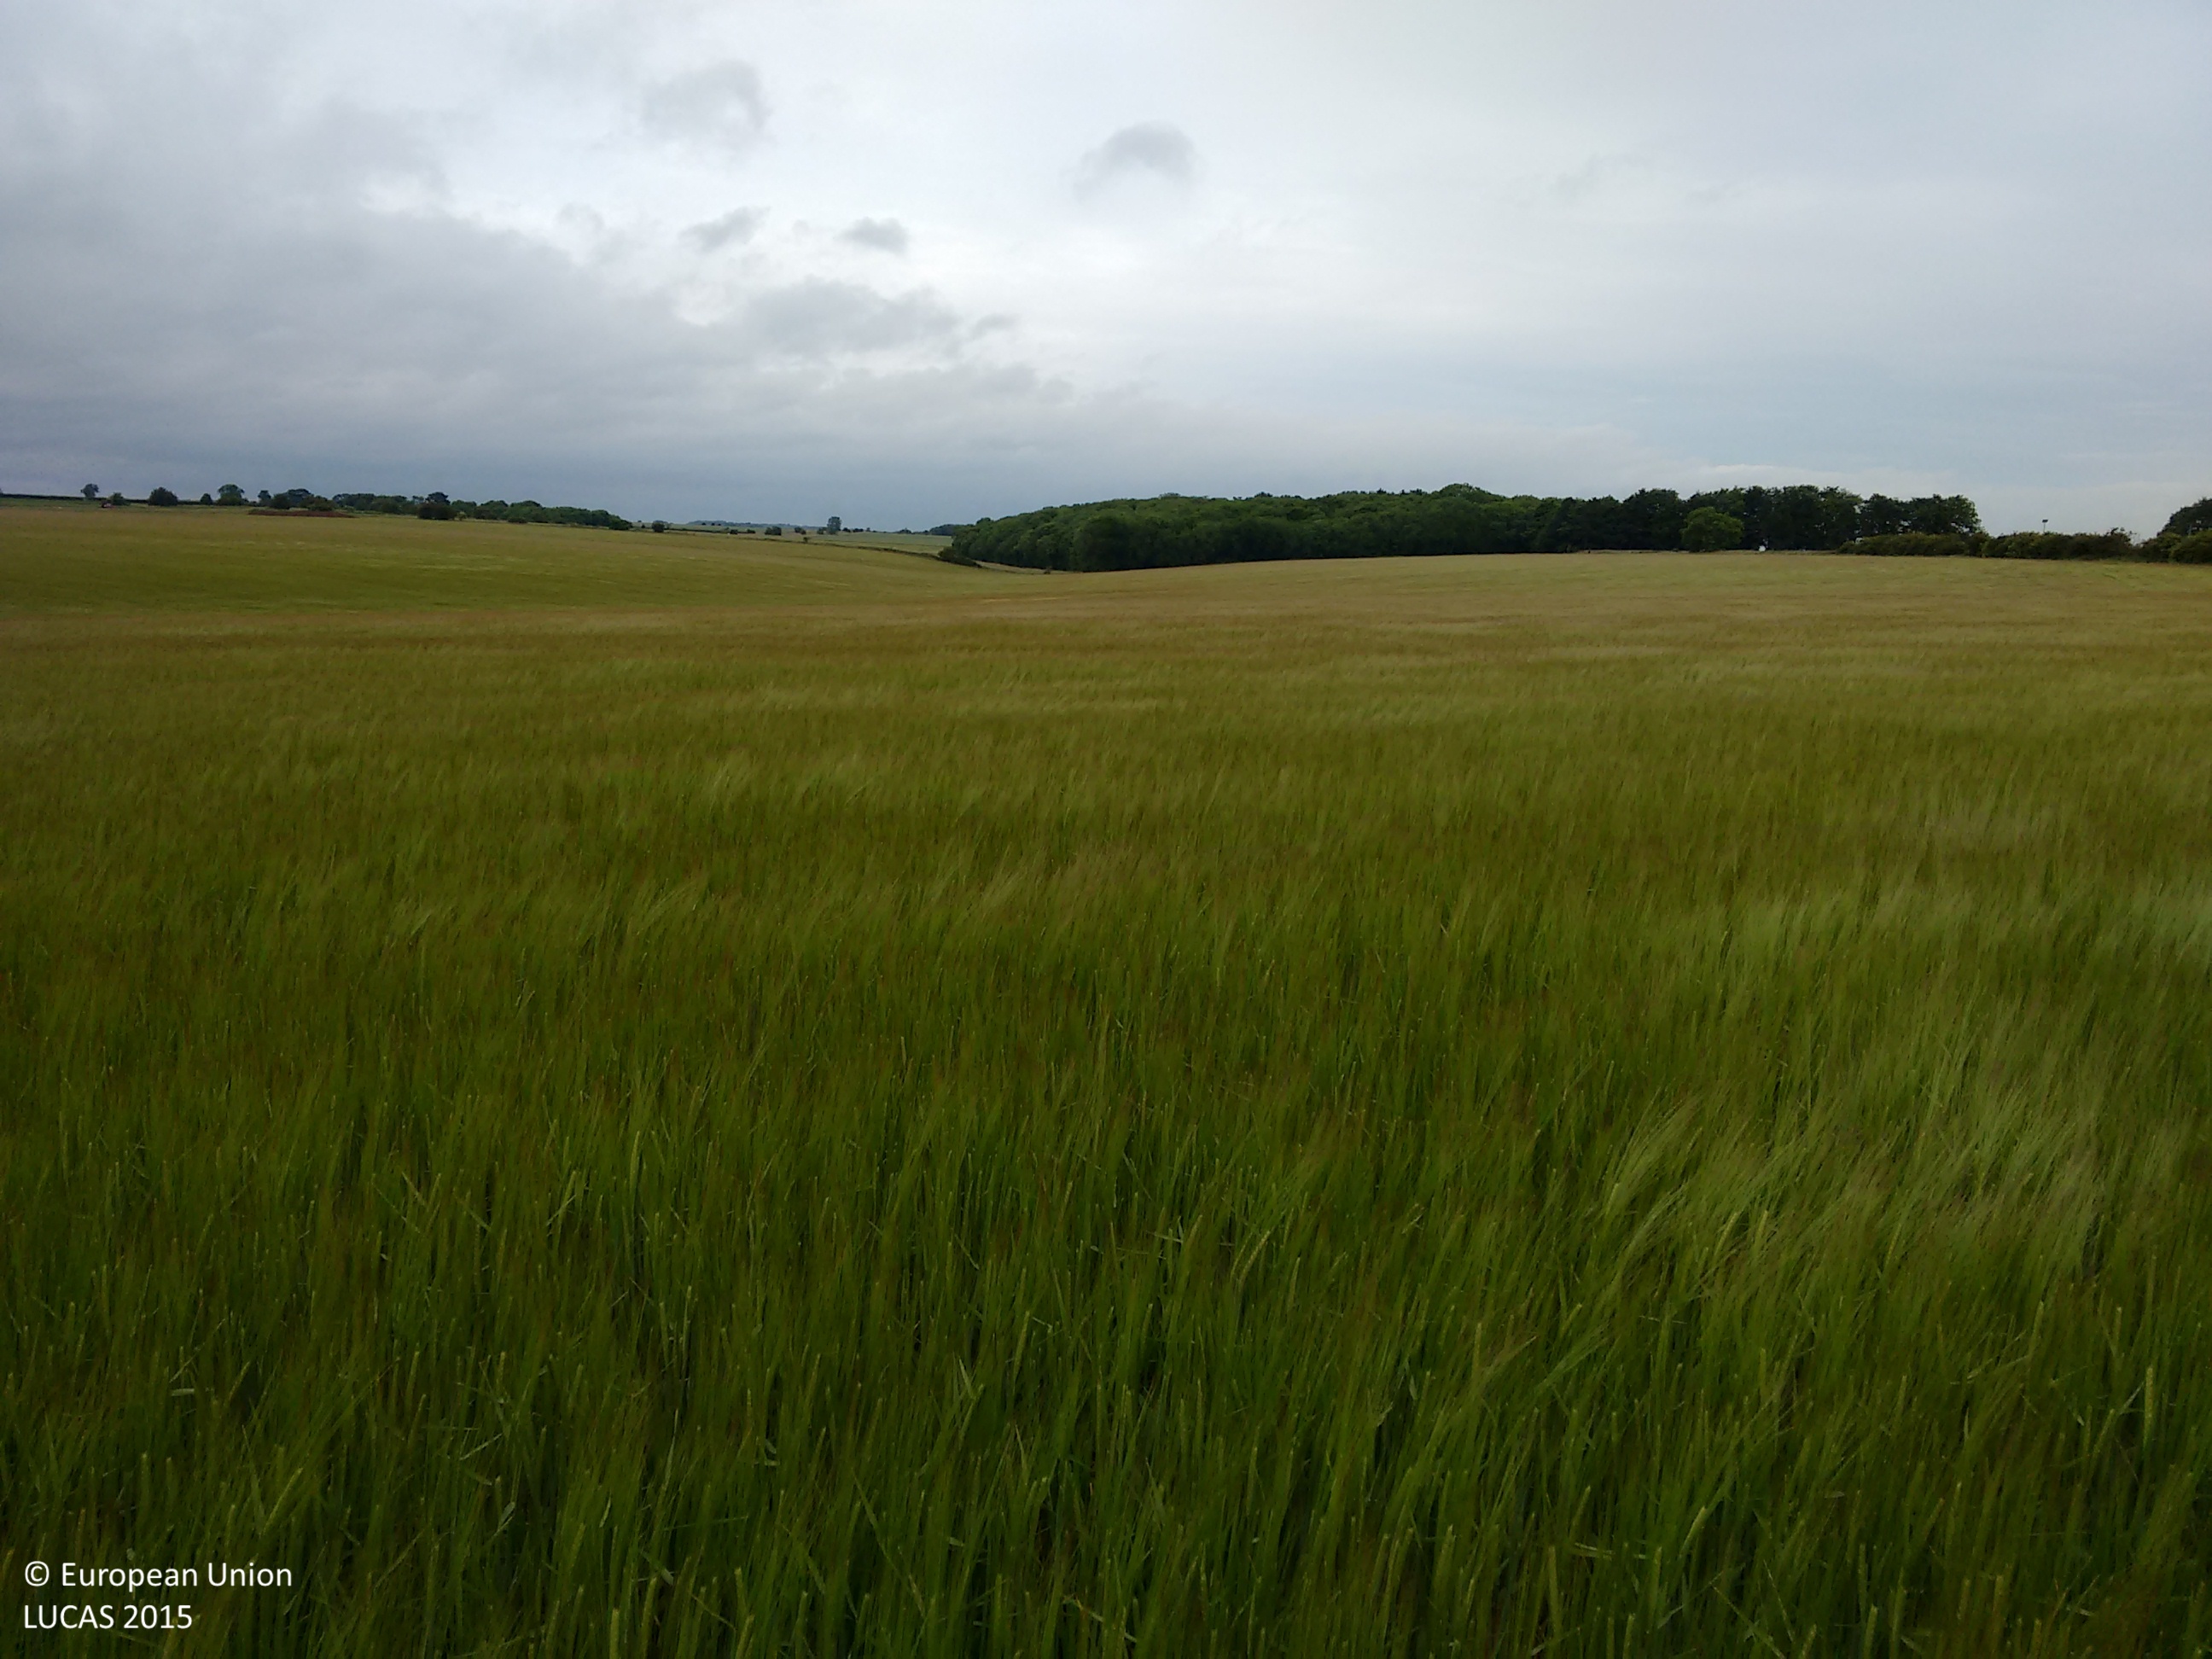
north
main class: Cropland
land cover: Barley
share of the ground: > 75 %
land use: Agriculture (excluding fallow land and kitchen gardens)
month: June
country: GB
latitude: 53.0330
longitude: -0.5211
